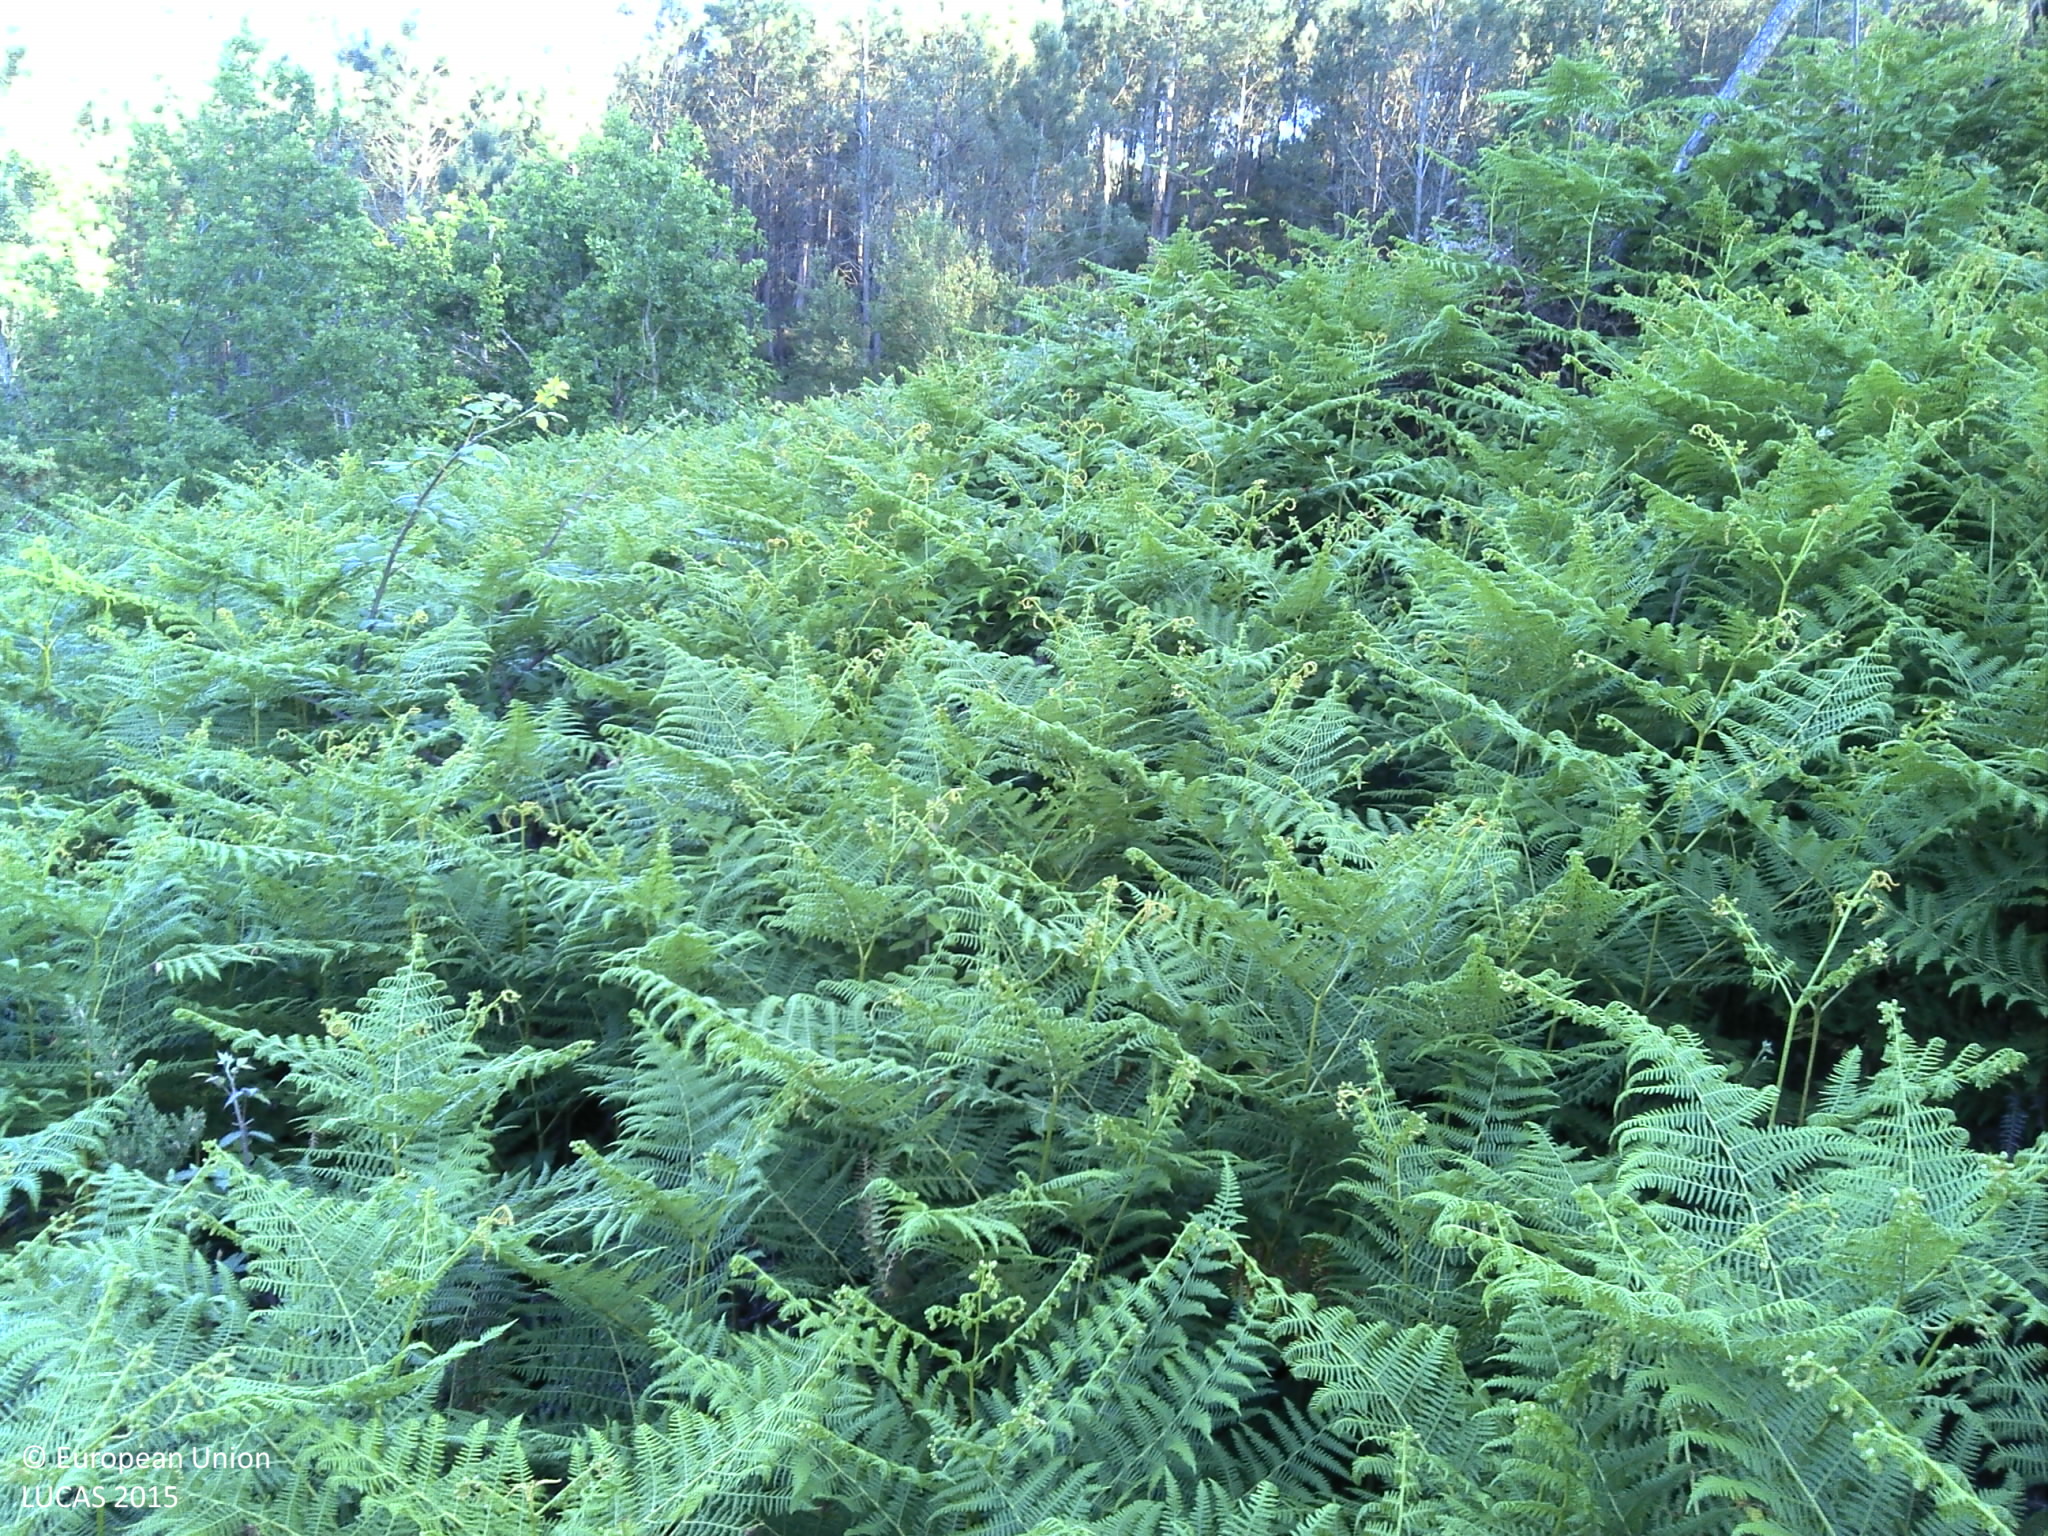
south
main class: Shrubland
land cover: Shrubland without tree cover
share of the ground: > 75 %
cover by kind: shrubs 90 %, herbaceous plants 10 %
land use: Semi-natural and natural areas not in use
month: May
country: PT
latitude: 41.8852
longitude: -8.6402
